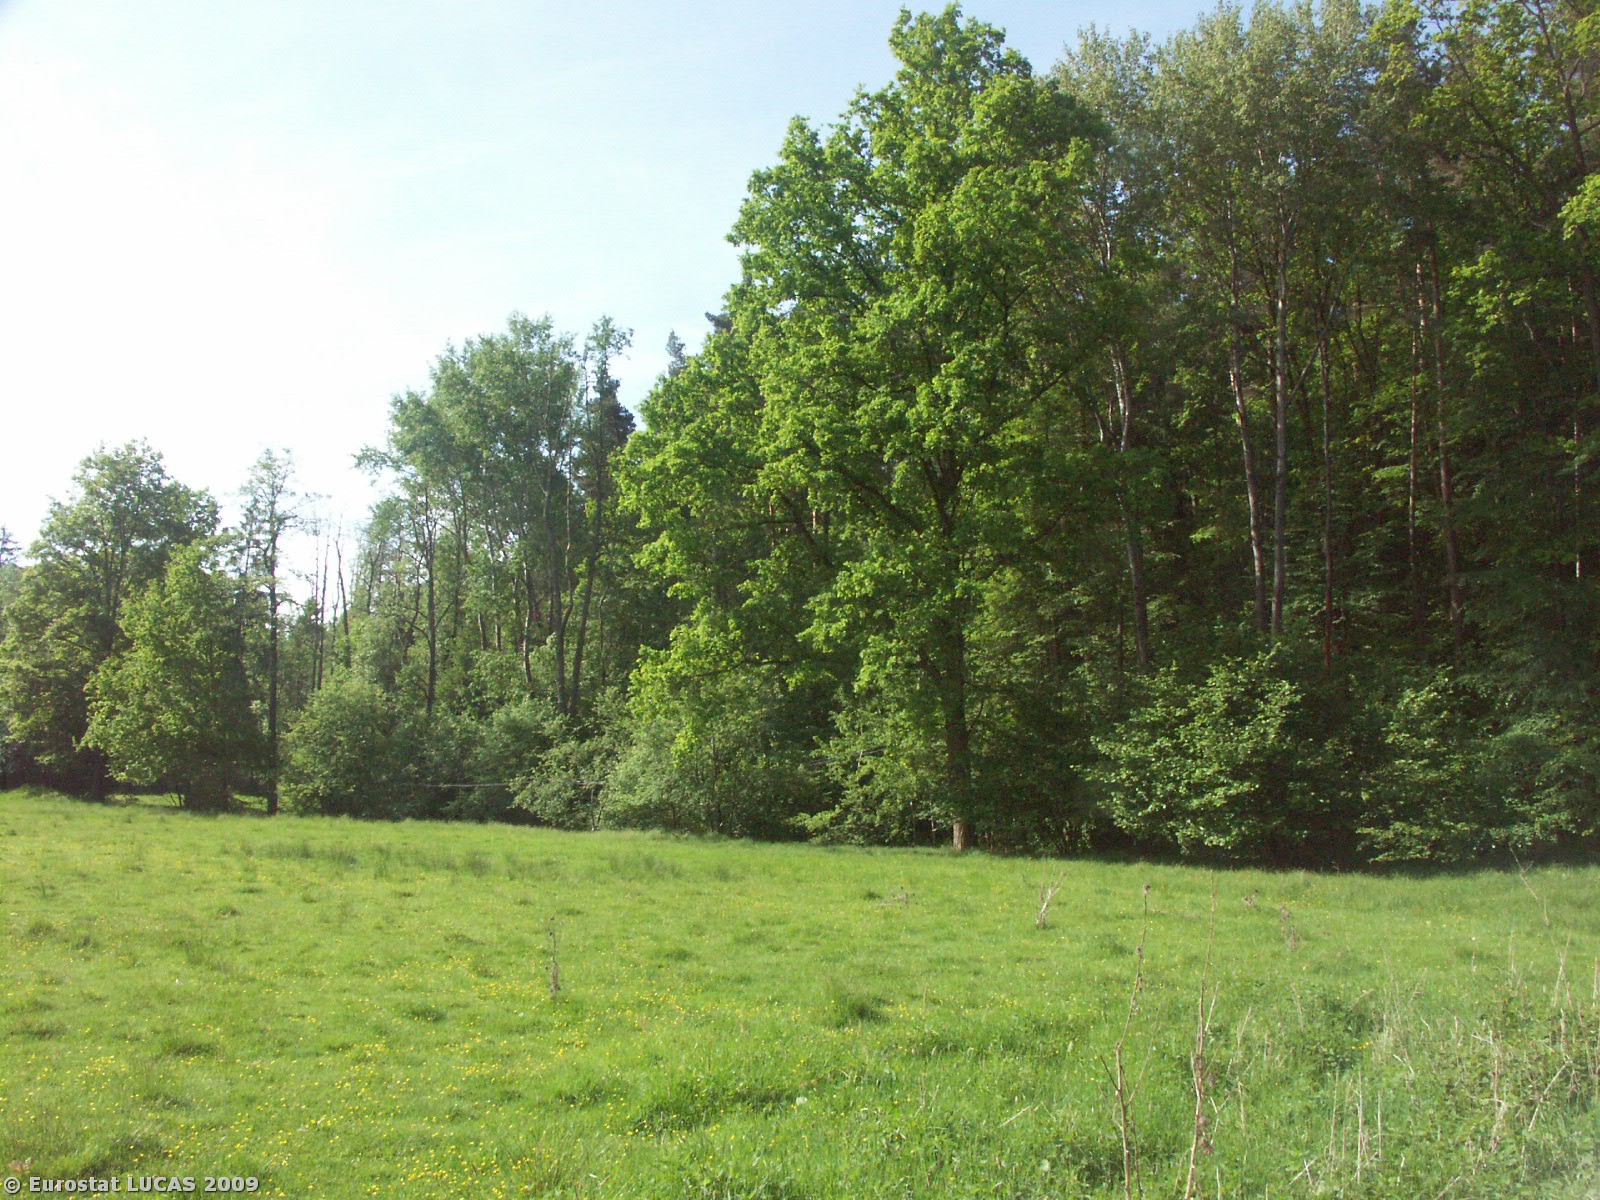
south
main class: Grassland
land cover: Grassland without tree/shrub cover
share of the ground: > 75 %
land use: Agriculture (excluding fallow land and kitchen gardens)
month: May
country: CZ
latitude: 48.8835
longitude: 14.6242
